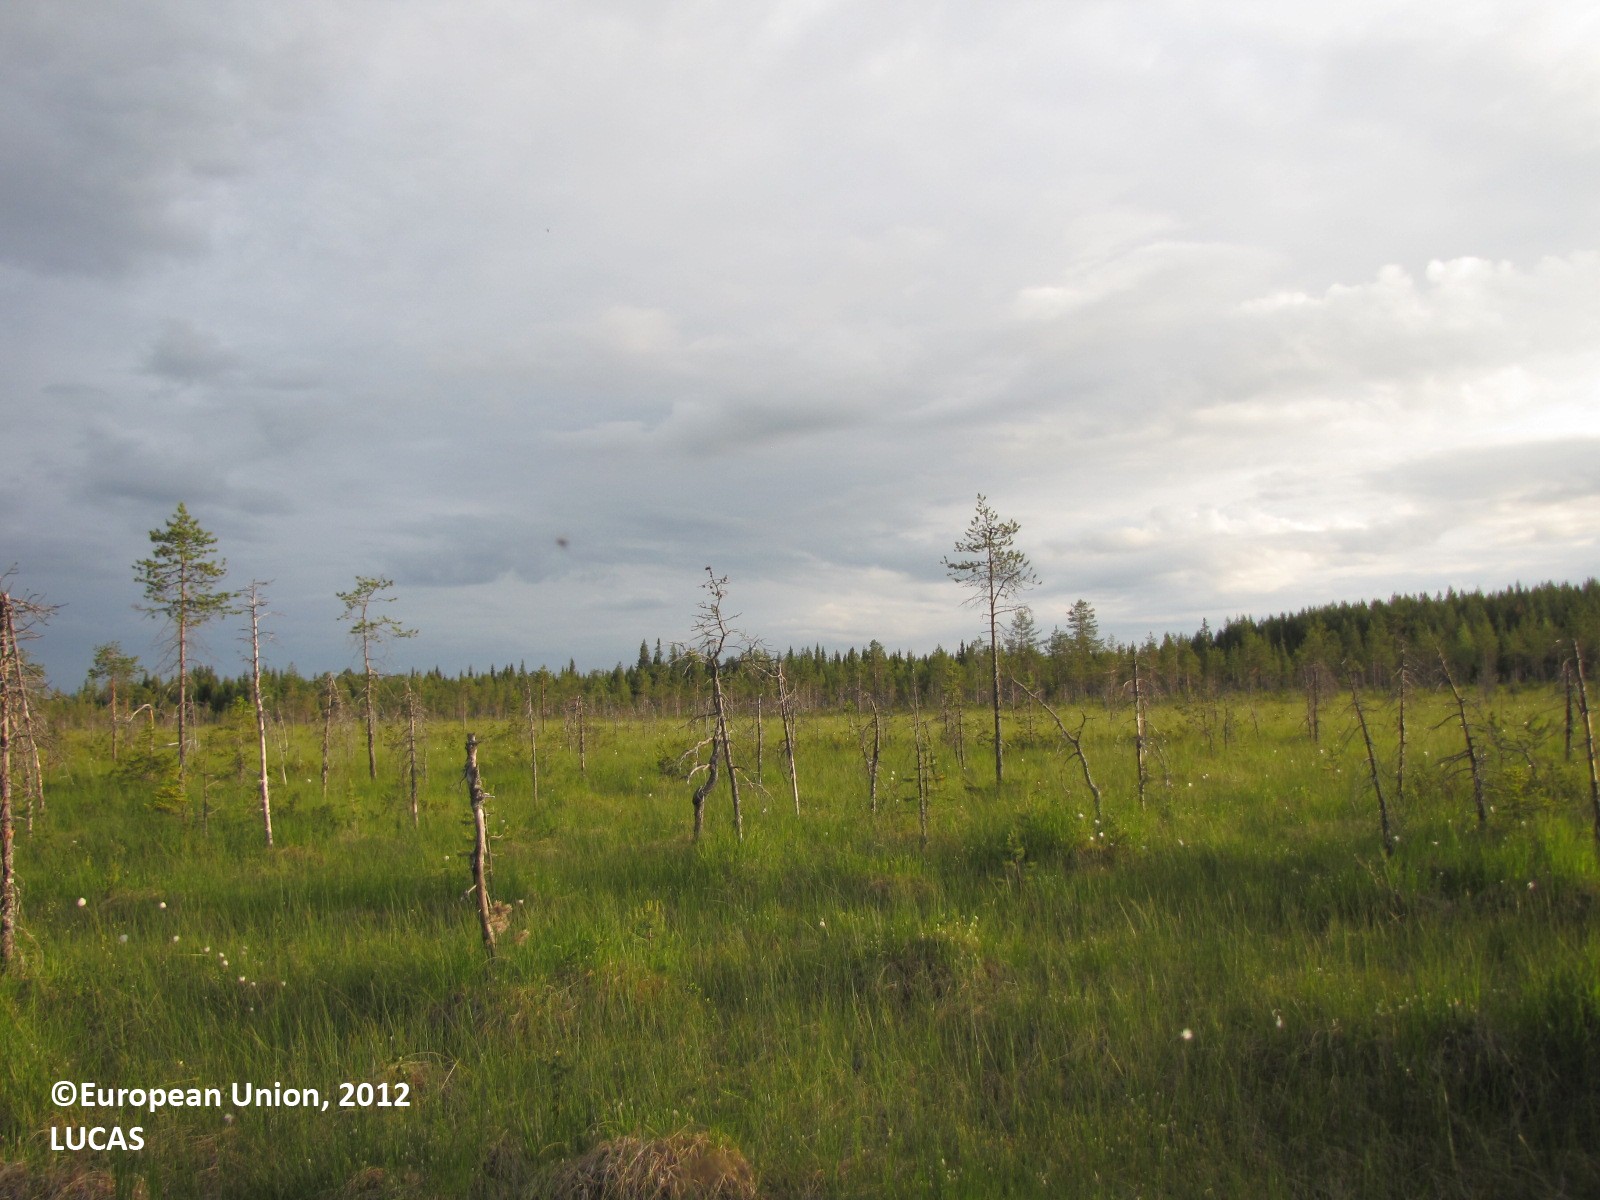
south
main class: Woodland
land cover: Pine dominated coniferous woodland
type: boreal forest
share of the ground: 10 - 25 %
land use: Forestry
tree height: > 5 m
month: July
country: FI
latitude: 66.3978
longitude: 24.9839
